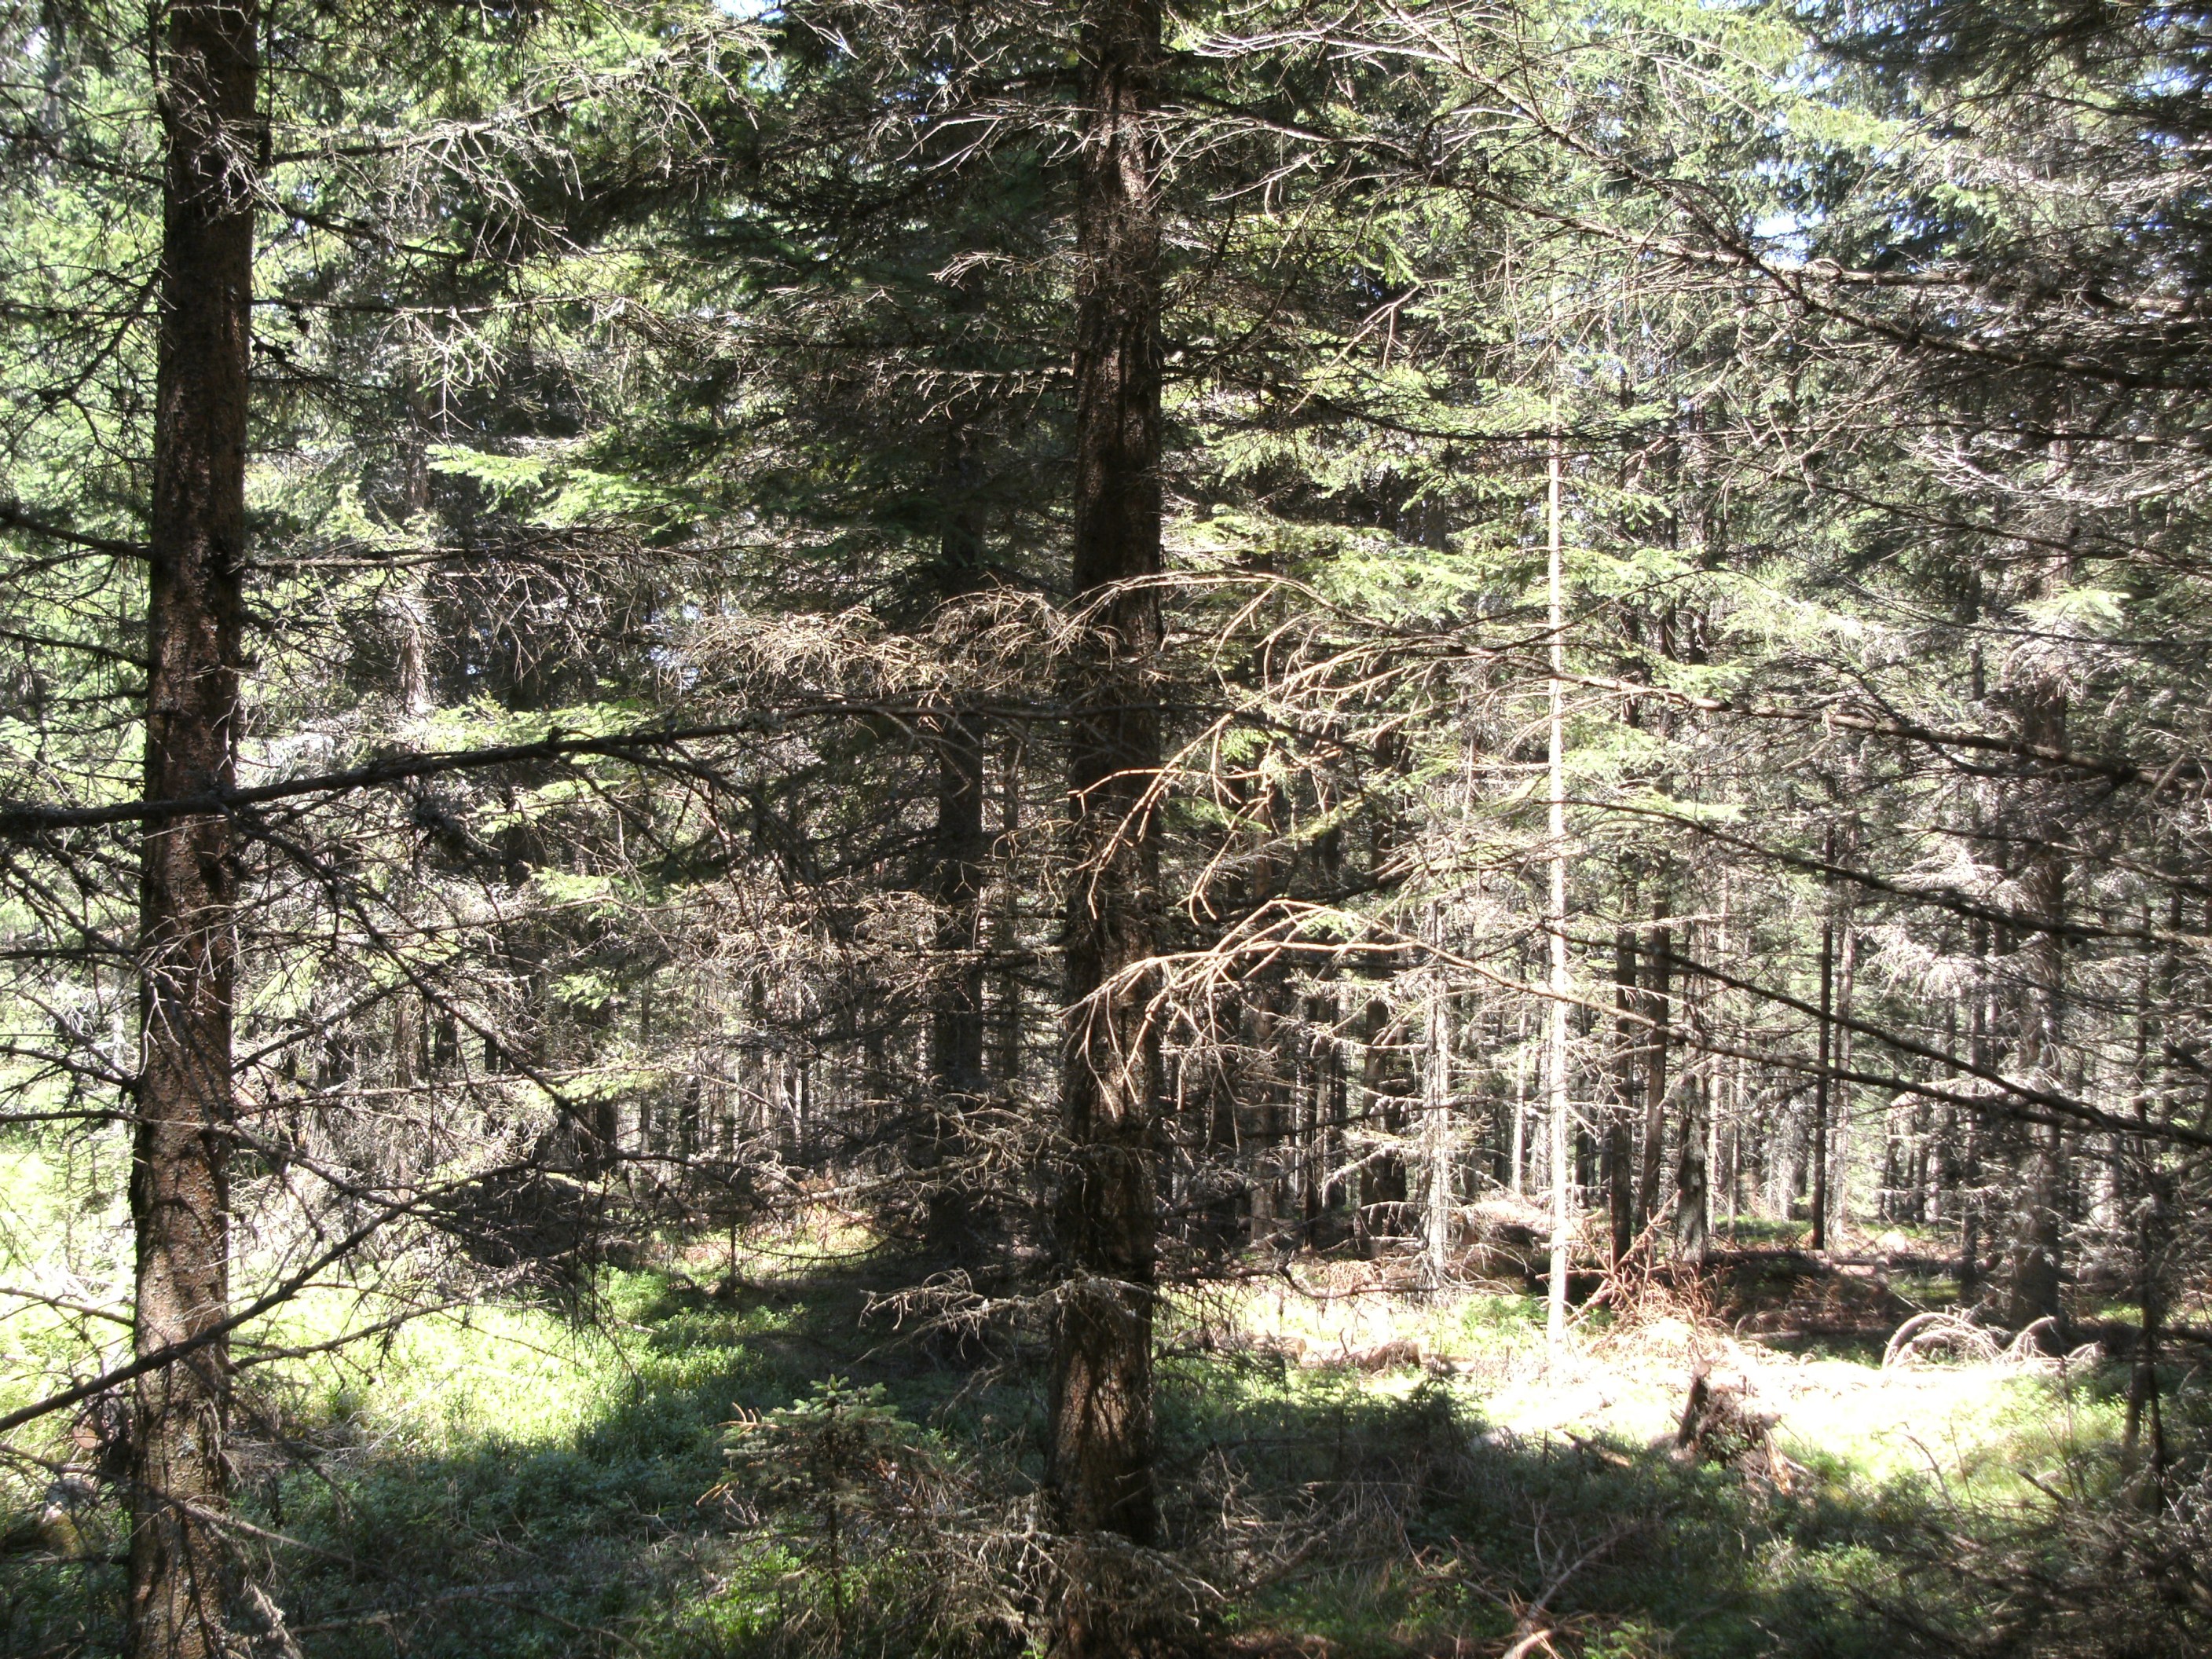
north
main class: Woodland
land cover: Spruce dominated coniferous woodland
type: alpine coniferous forest
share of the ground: 50 - 75 %
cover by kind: coniferous forest trees 75 %, shrubs 15 %, herbaceous plants 10 %
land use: Forestry
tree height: > 5 m
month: July
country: AT
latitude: 46.9043
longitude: 14.9478
